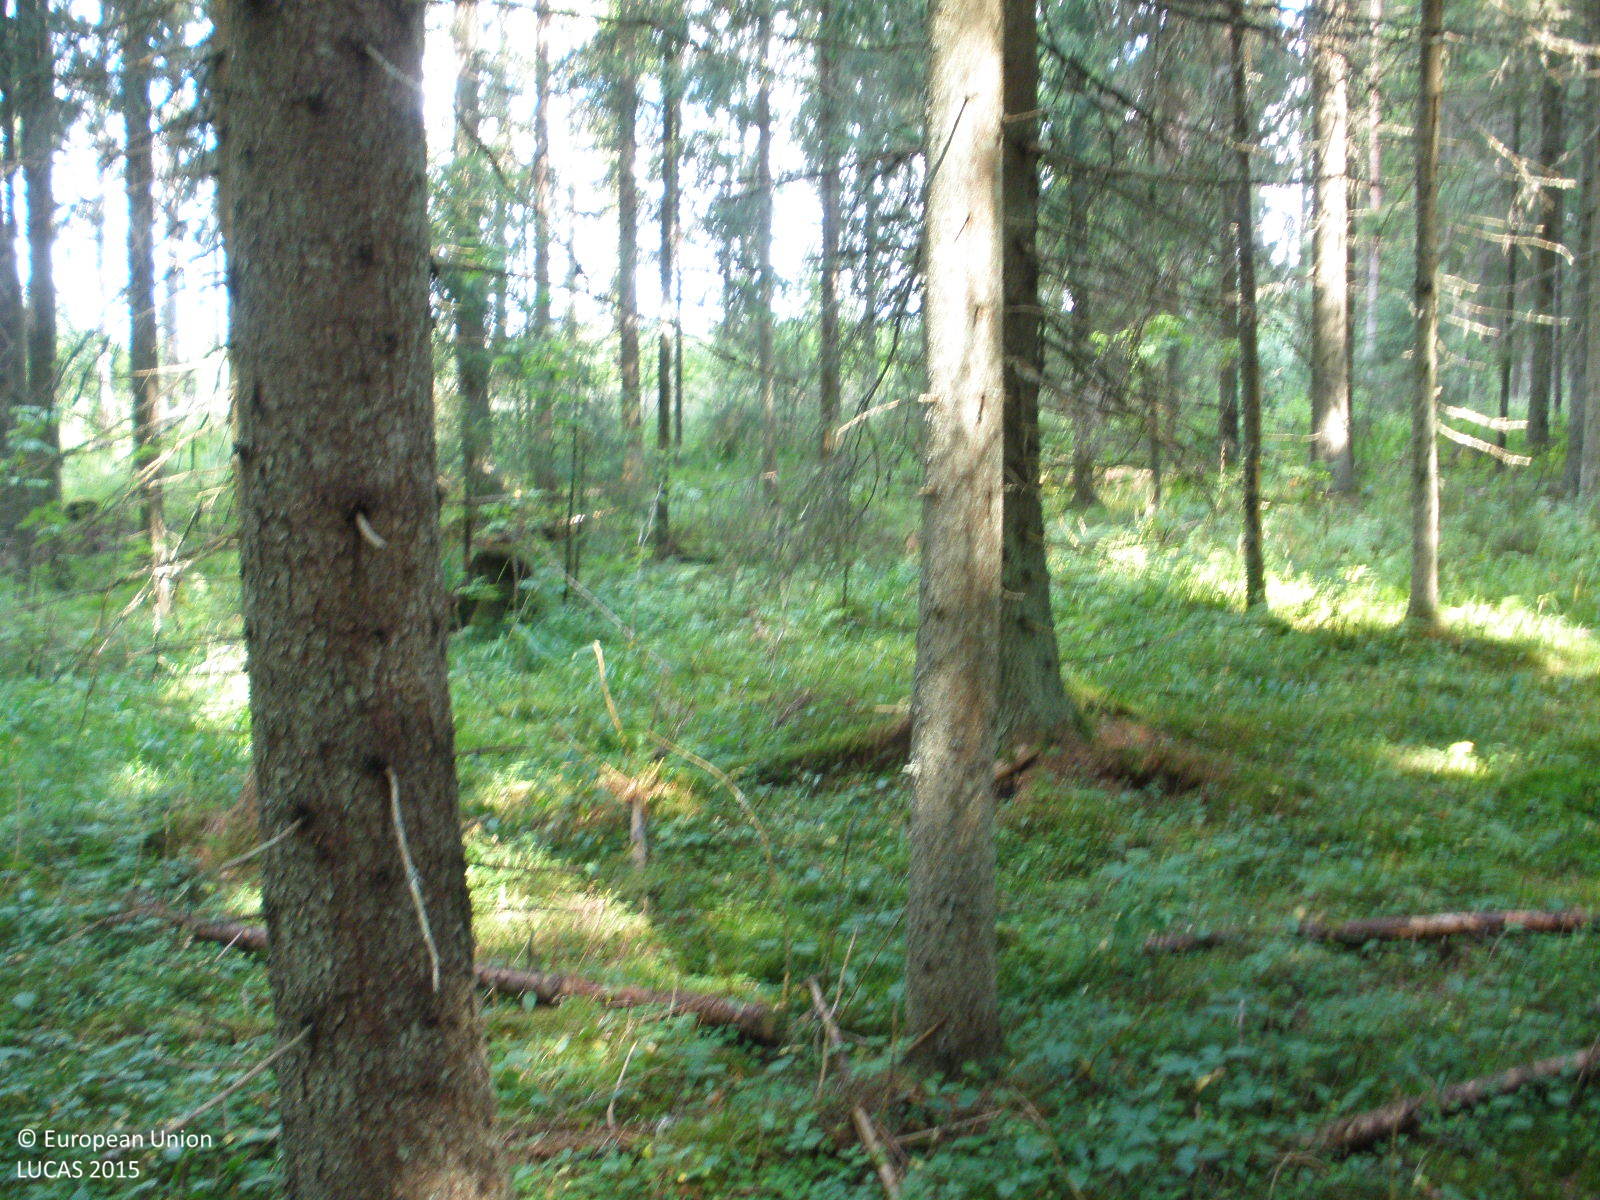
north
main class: Woodland
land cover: Spruce dominated coniferous woodland
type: boreal forest
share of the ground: > 75 %
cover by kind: coniferous forest trees 90 %, herbaceous plants 5 %, lichens and mosses 5 %
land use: Forestry
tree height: > 5 m
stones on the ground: < 10 %
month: August
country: FI
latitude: 60.9802
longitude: 24.9137
